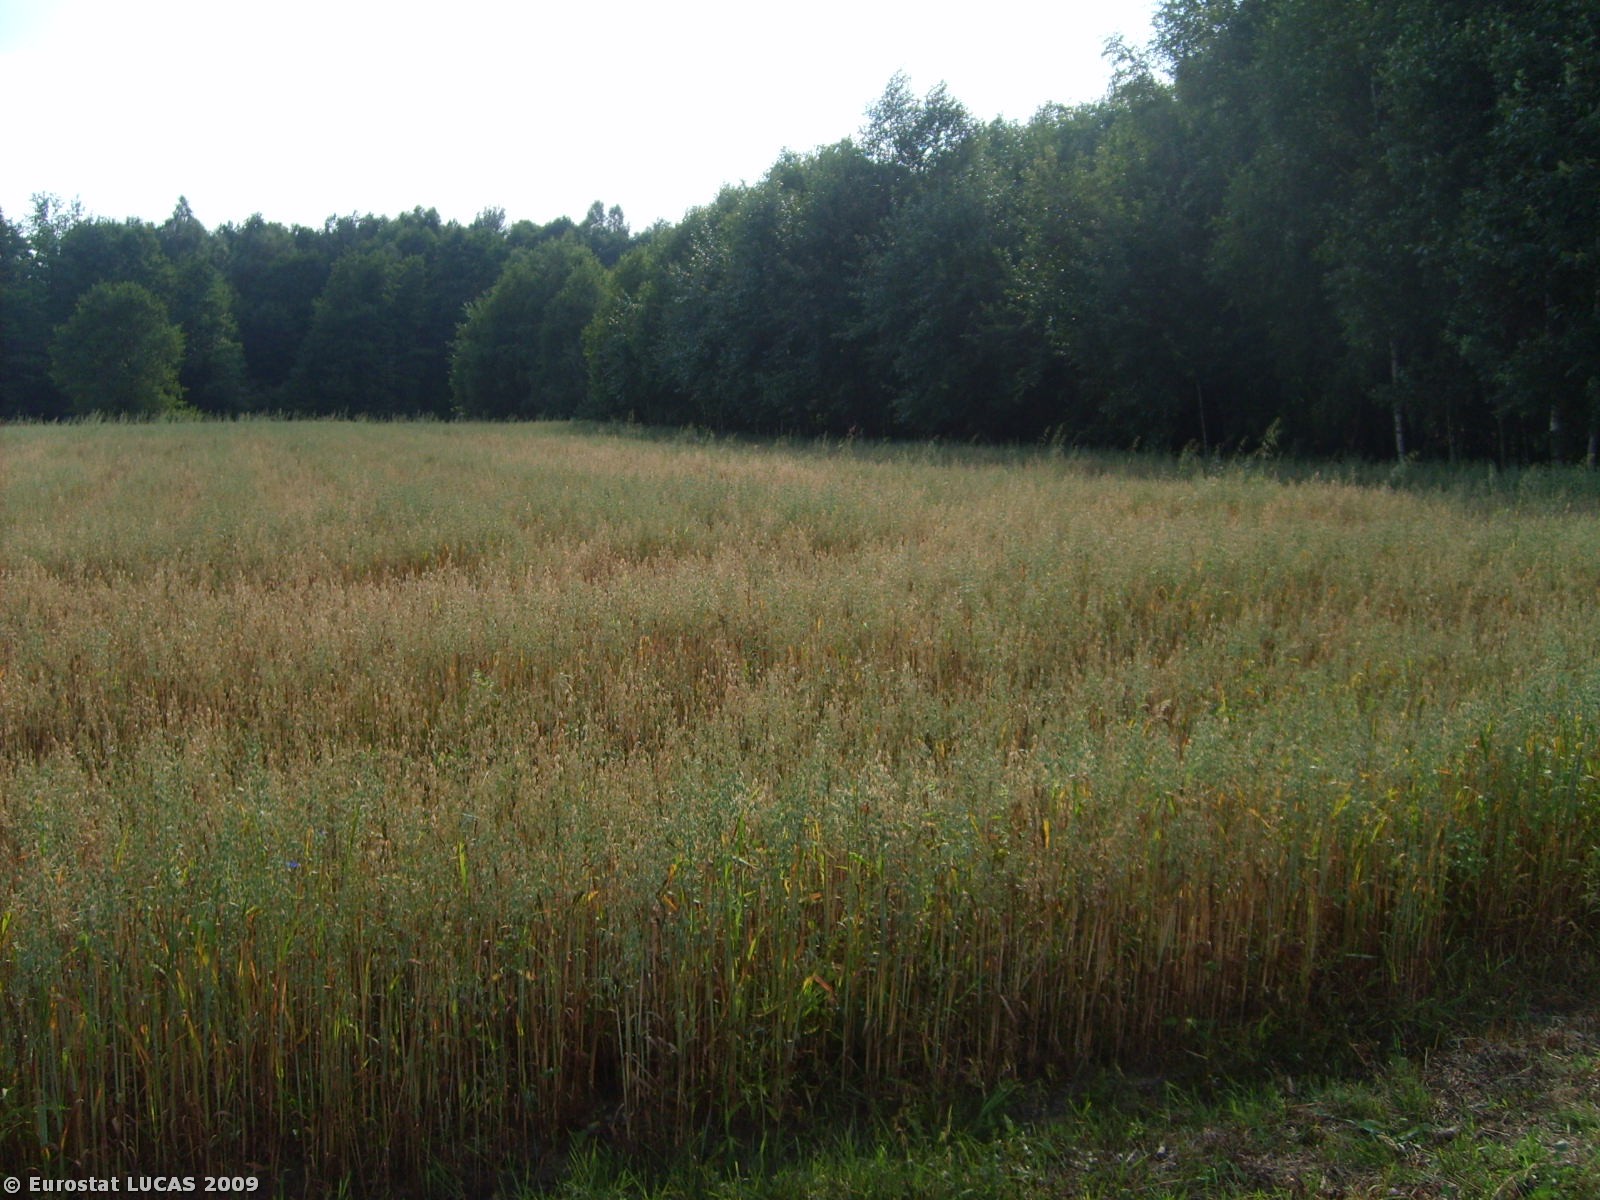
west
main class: Grassland
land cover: Grassland without tree/shrub cover
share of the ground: > 75 %
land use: Unused
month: July
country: PL
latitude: 52.4486
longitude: 21.7220
